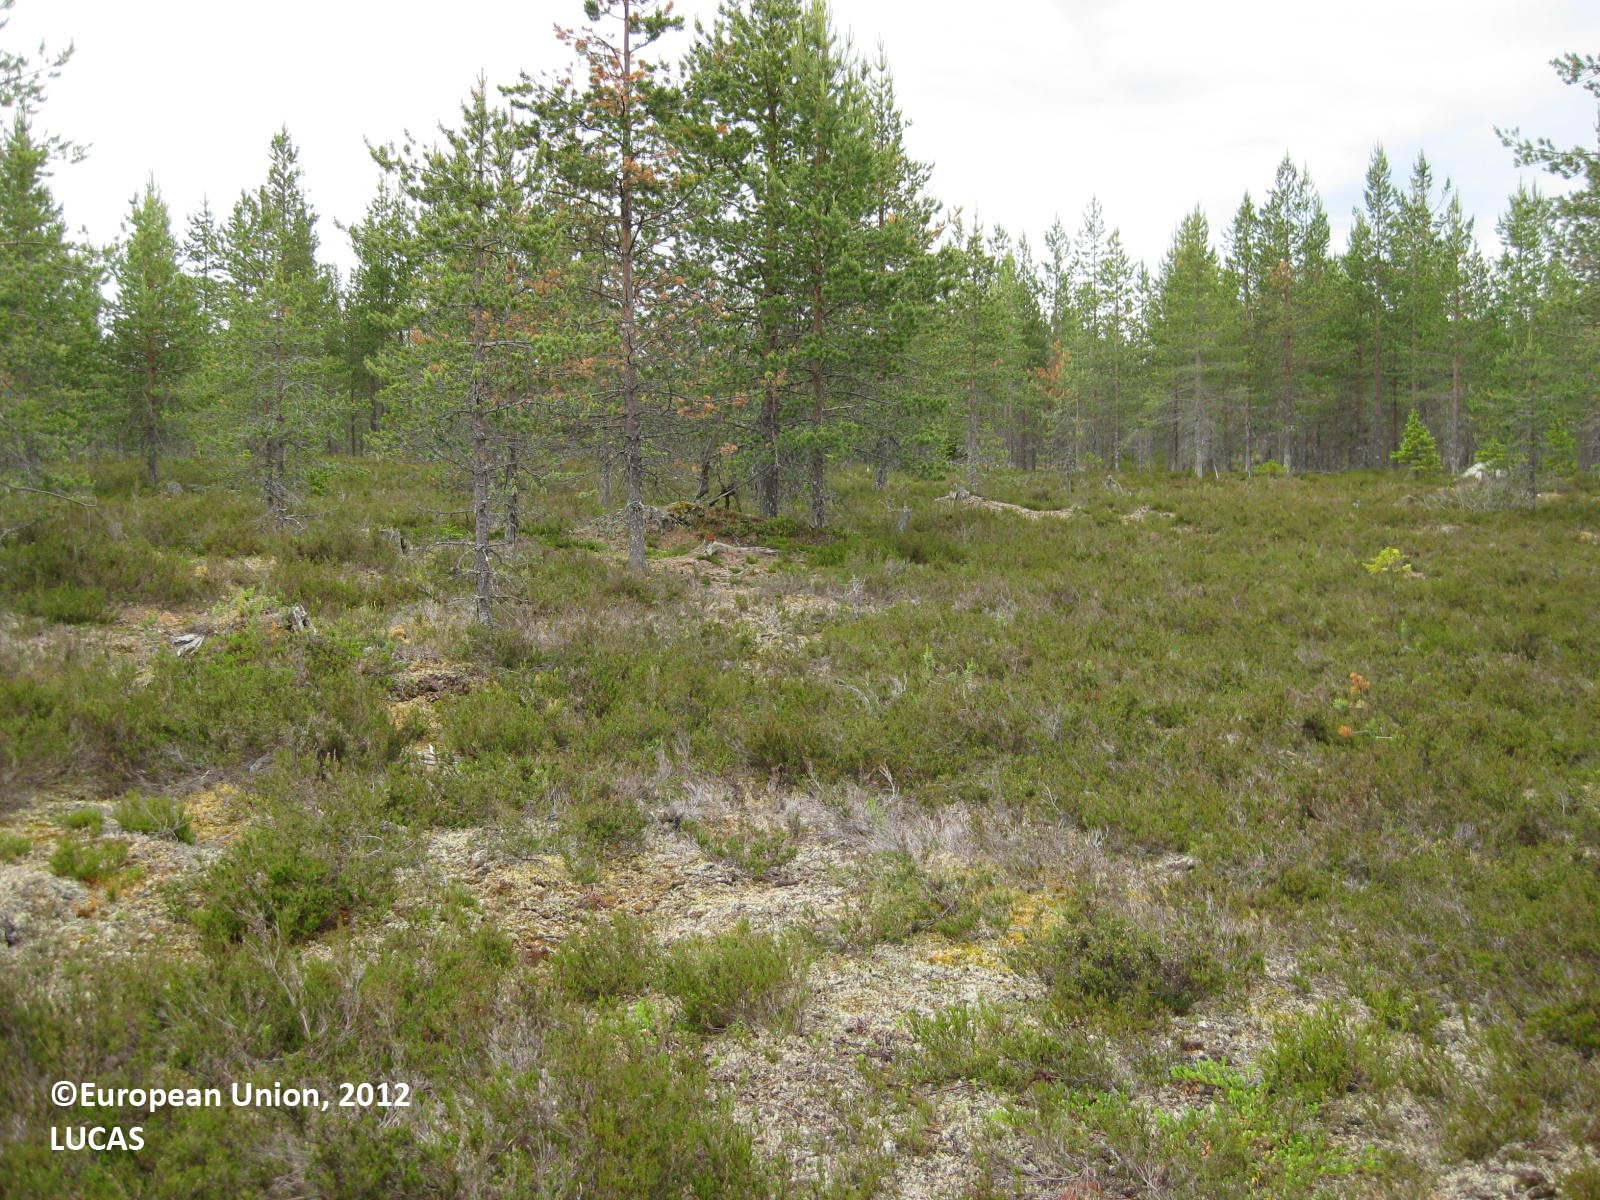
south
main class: Woodland
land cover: Pine dominated coniferous woodland
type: boreal forest
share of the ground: 25 - 50 %
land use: Forestry
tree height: > 5 m
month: July
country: FI
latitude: 65.5988
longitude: 29.2558
